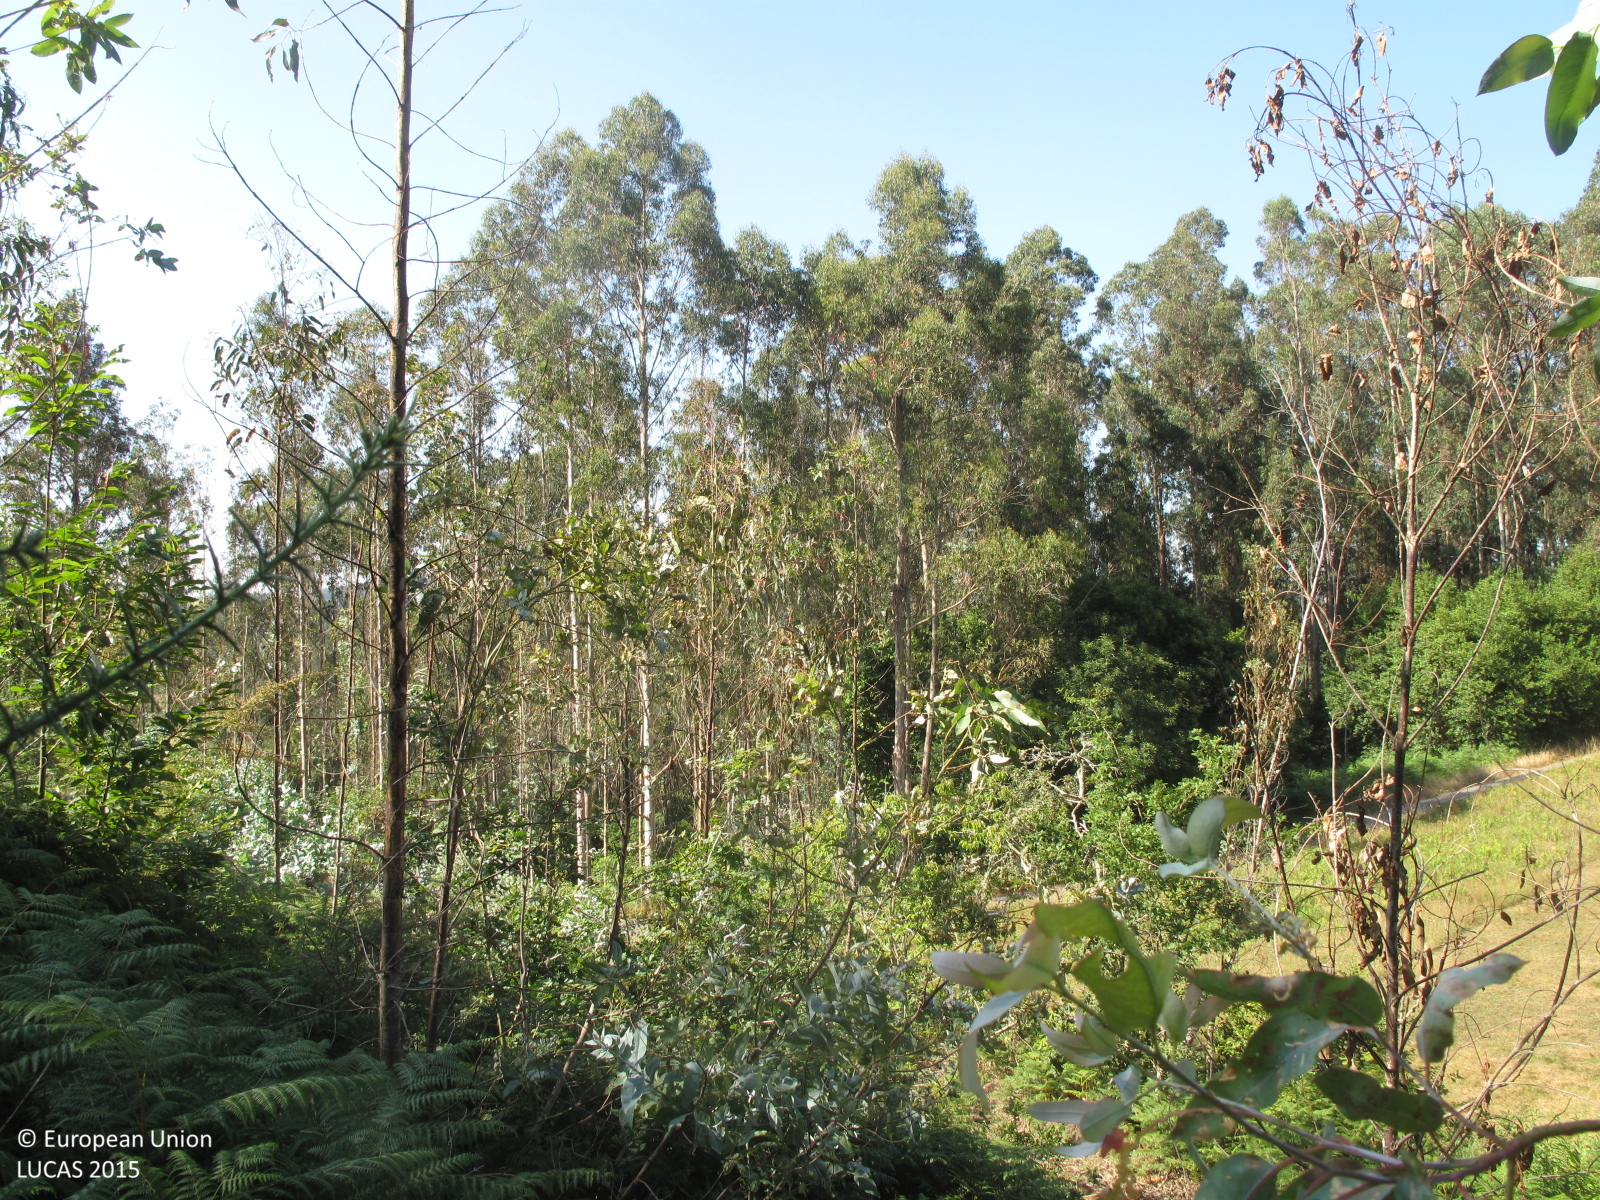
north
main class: Grassland
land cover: Grassland with sparse tree/shrub cover
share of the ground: 50 - 75 %
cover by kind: herbaceous plants 70 %, unconsolidated bare surface 20 %, broadleaved forest trees 5 %, shrubs 5 %
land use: Forestry
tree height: < 5 m
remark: Clear cut
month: July
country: ES
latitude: 43.3518
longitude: -8.0974
